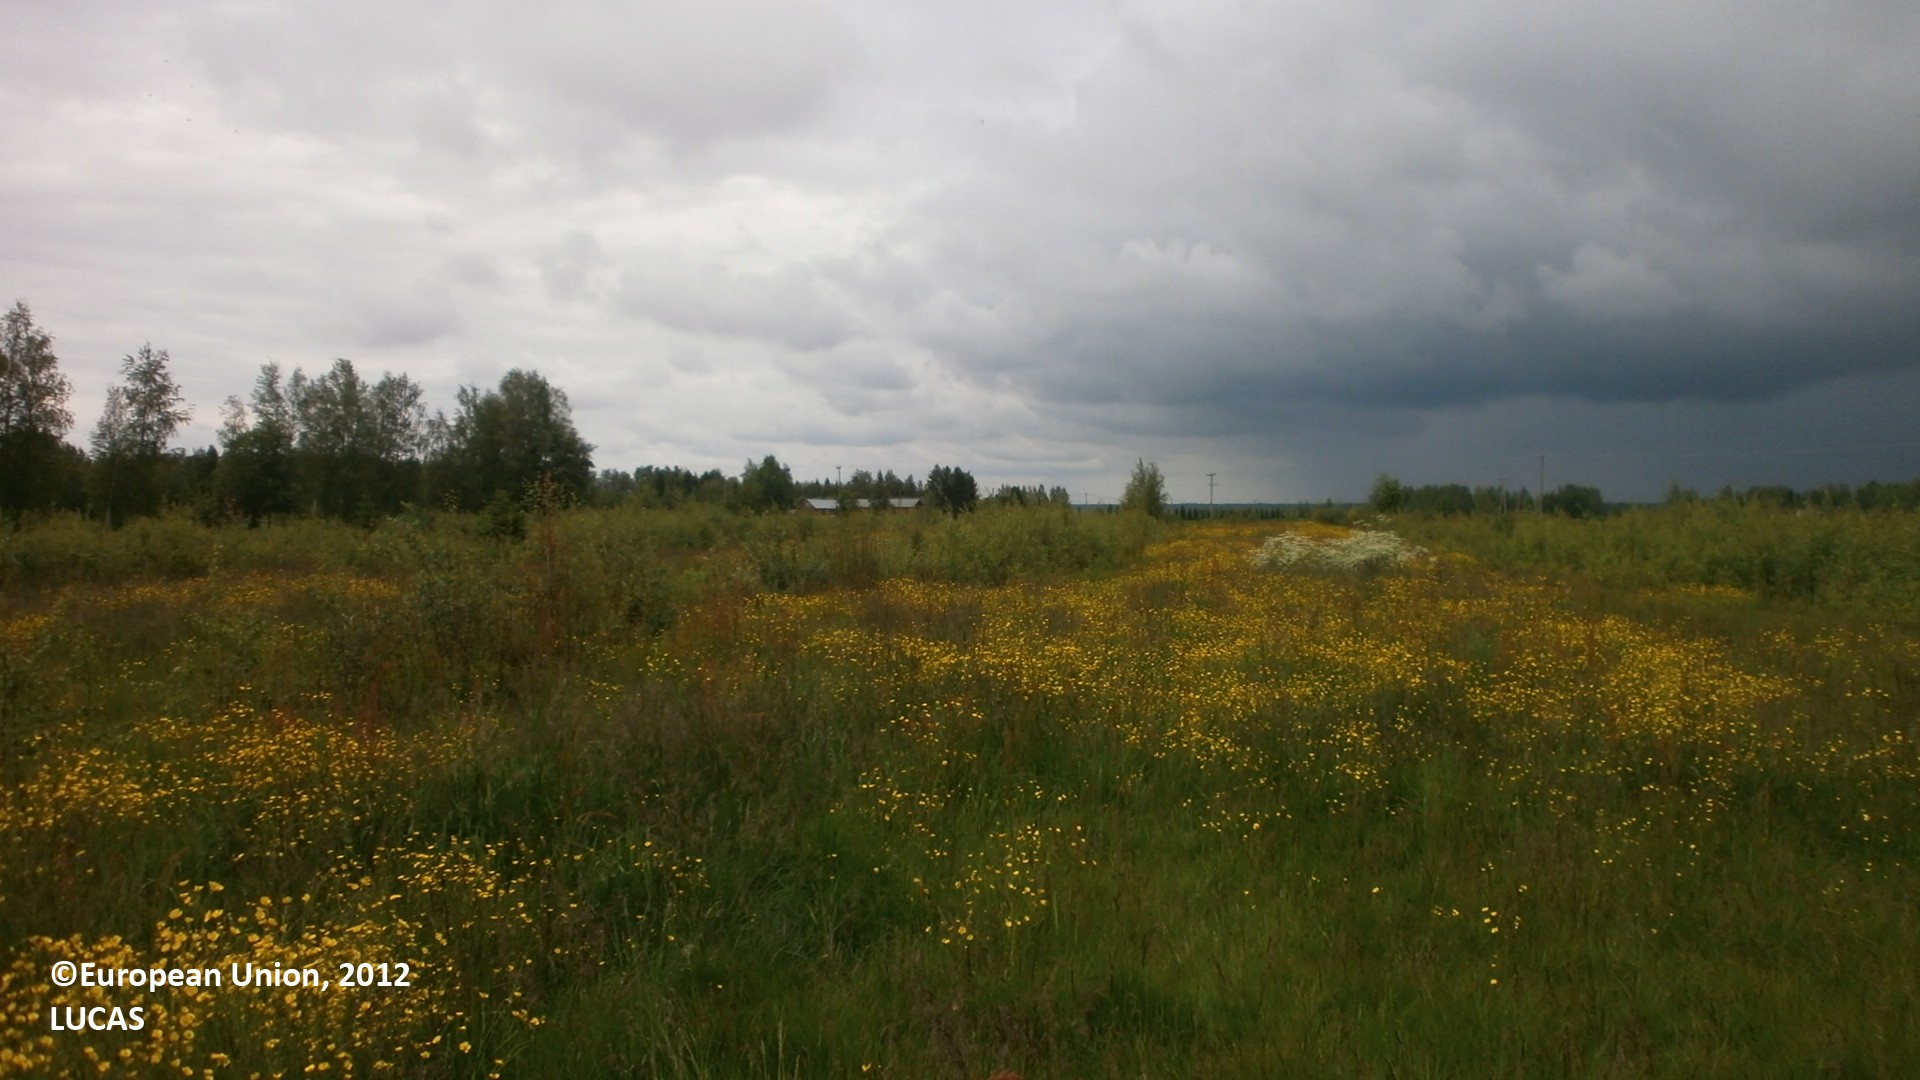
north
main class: Grassland
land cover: Grassland without tree/shrub cover
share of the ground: > 75 %
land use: Agriculture (excluding fallow land and kitchen gardens)
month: June
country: FI
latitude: 64.8133
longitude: 25.3082
